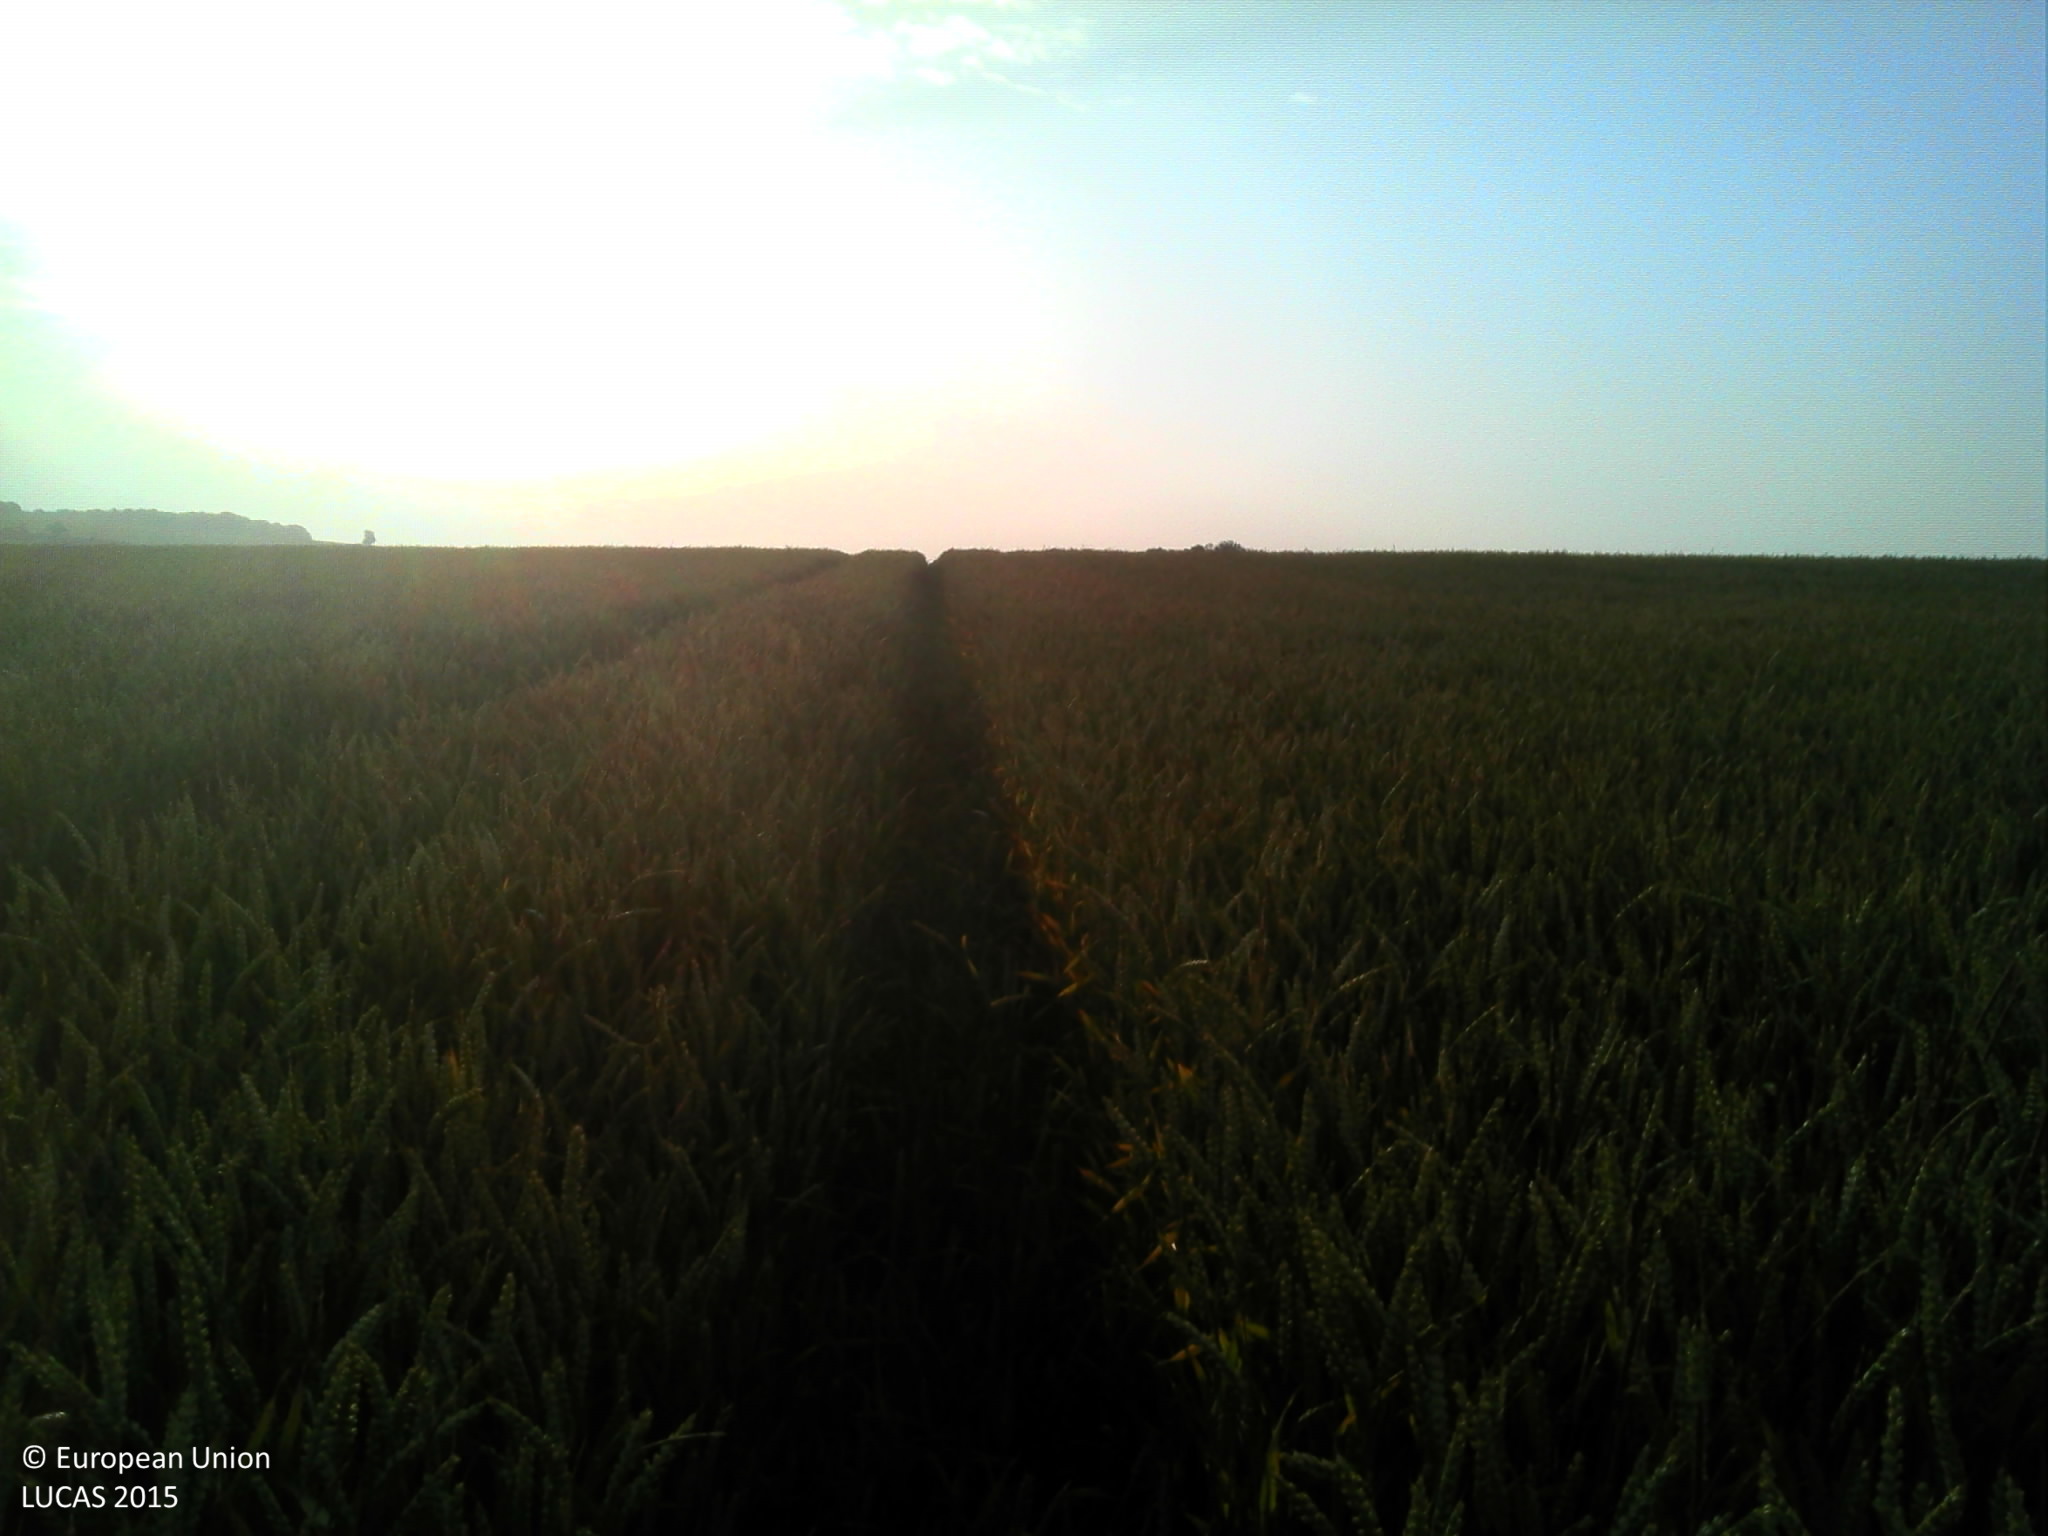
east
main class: Cropland
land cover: Common wheat
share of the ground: > 75 %
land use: Agriculture (excluding fallow land and kitchen gardens)
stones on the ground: 10 - 25 %
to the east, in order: Common wheat
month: July
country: FR
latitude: 49.7852
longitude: 2.3898
